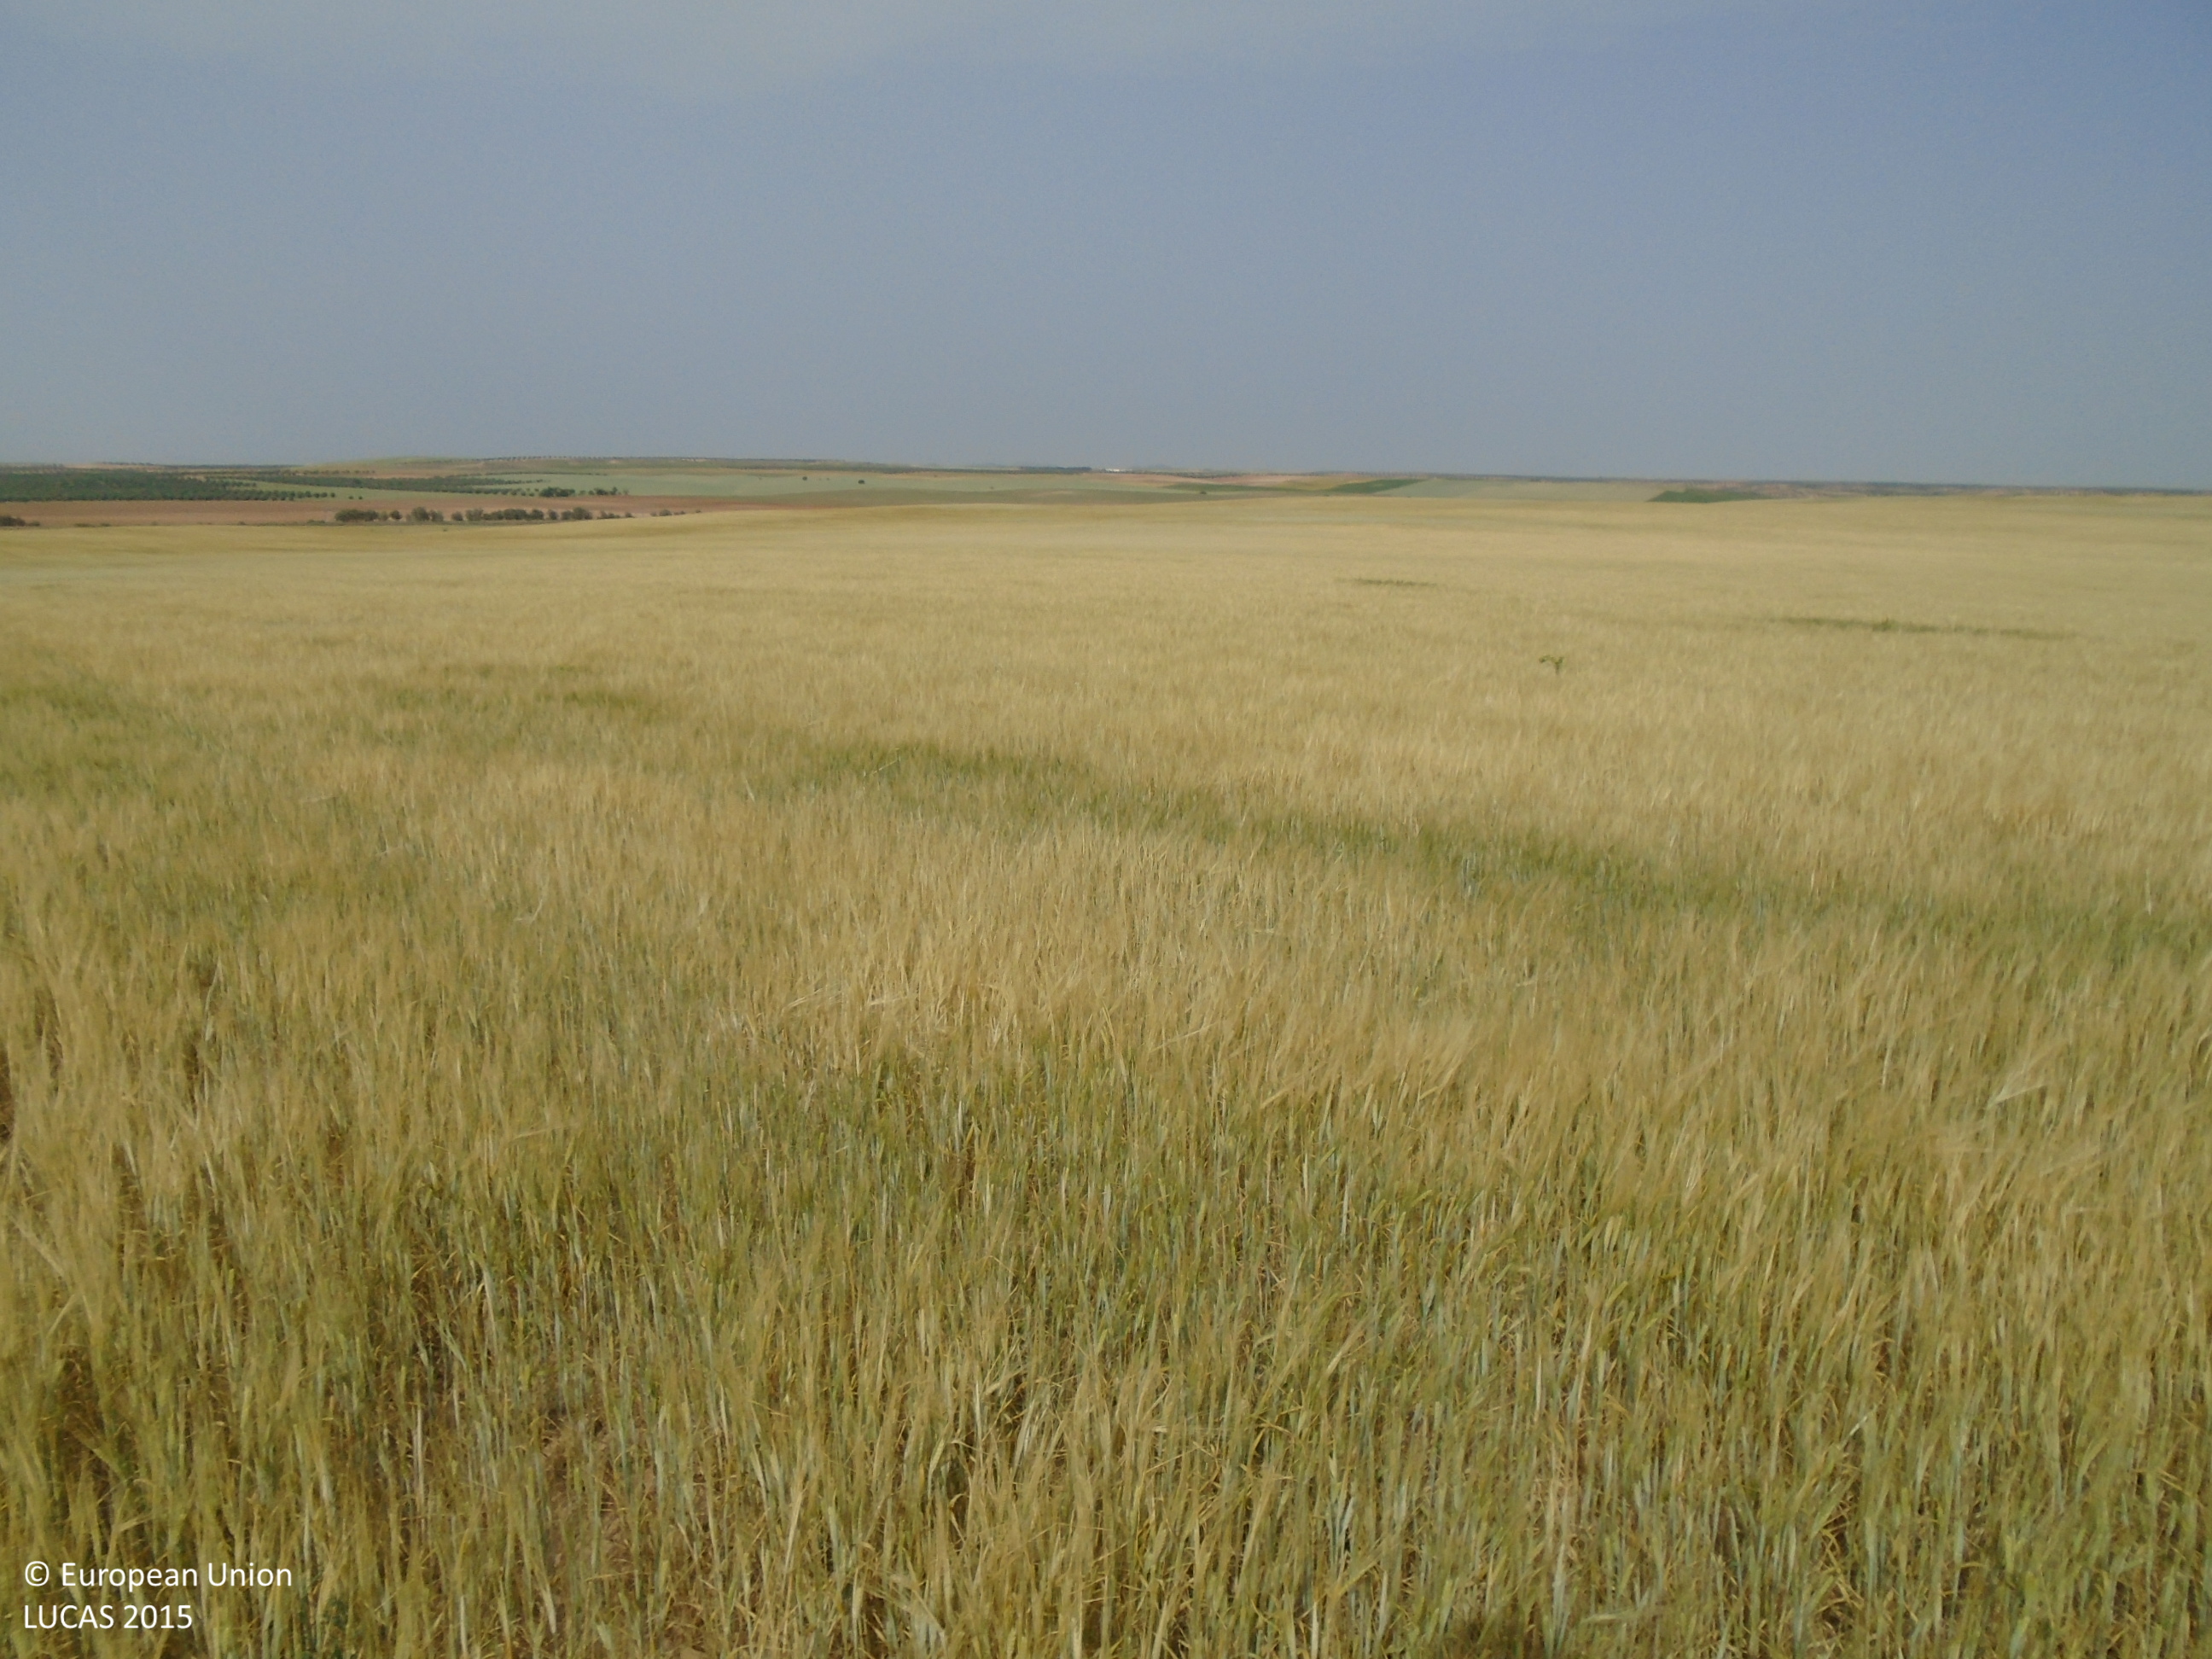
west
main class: Cropland
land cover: Barley
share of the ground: > 75 %
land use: Agriculture (excluding fallow land and kitchen gardens)
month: May
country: ES
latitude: 39.7905
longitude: -3.6091
